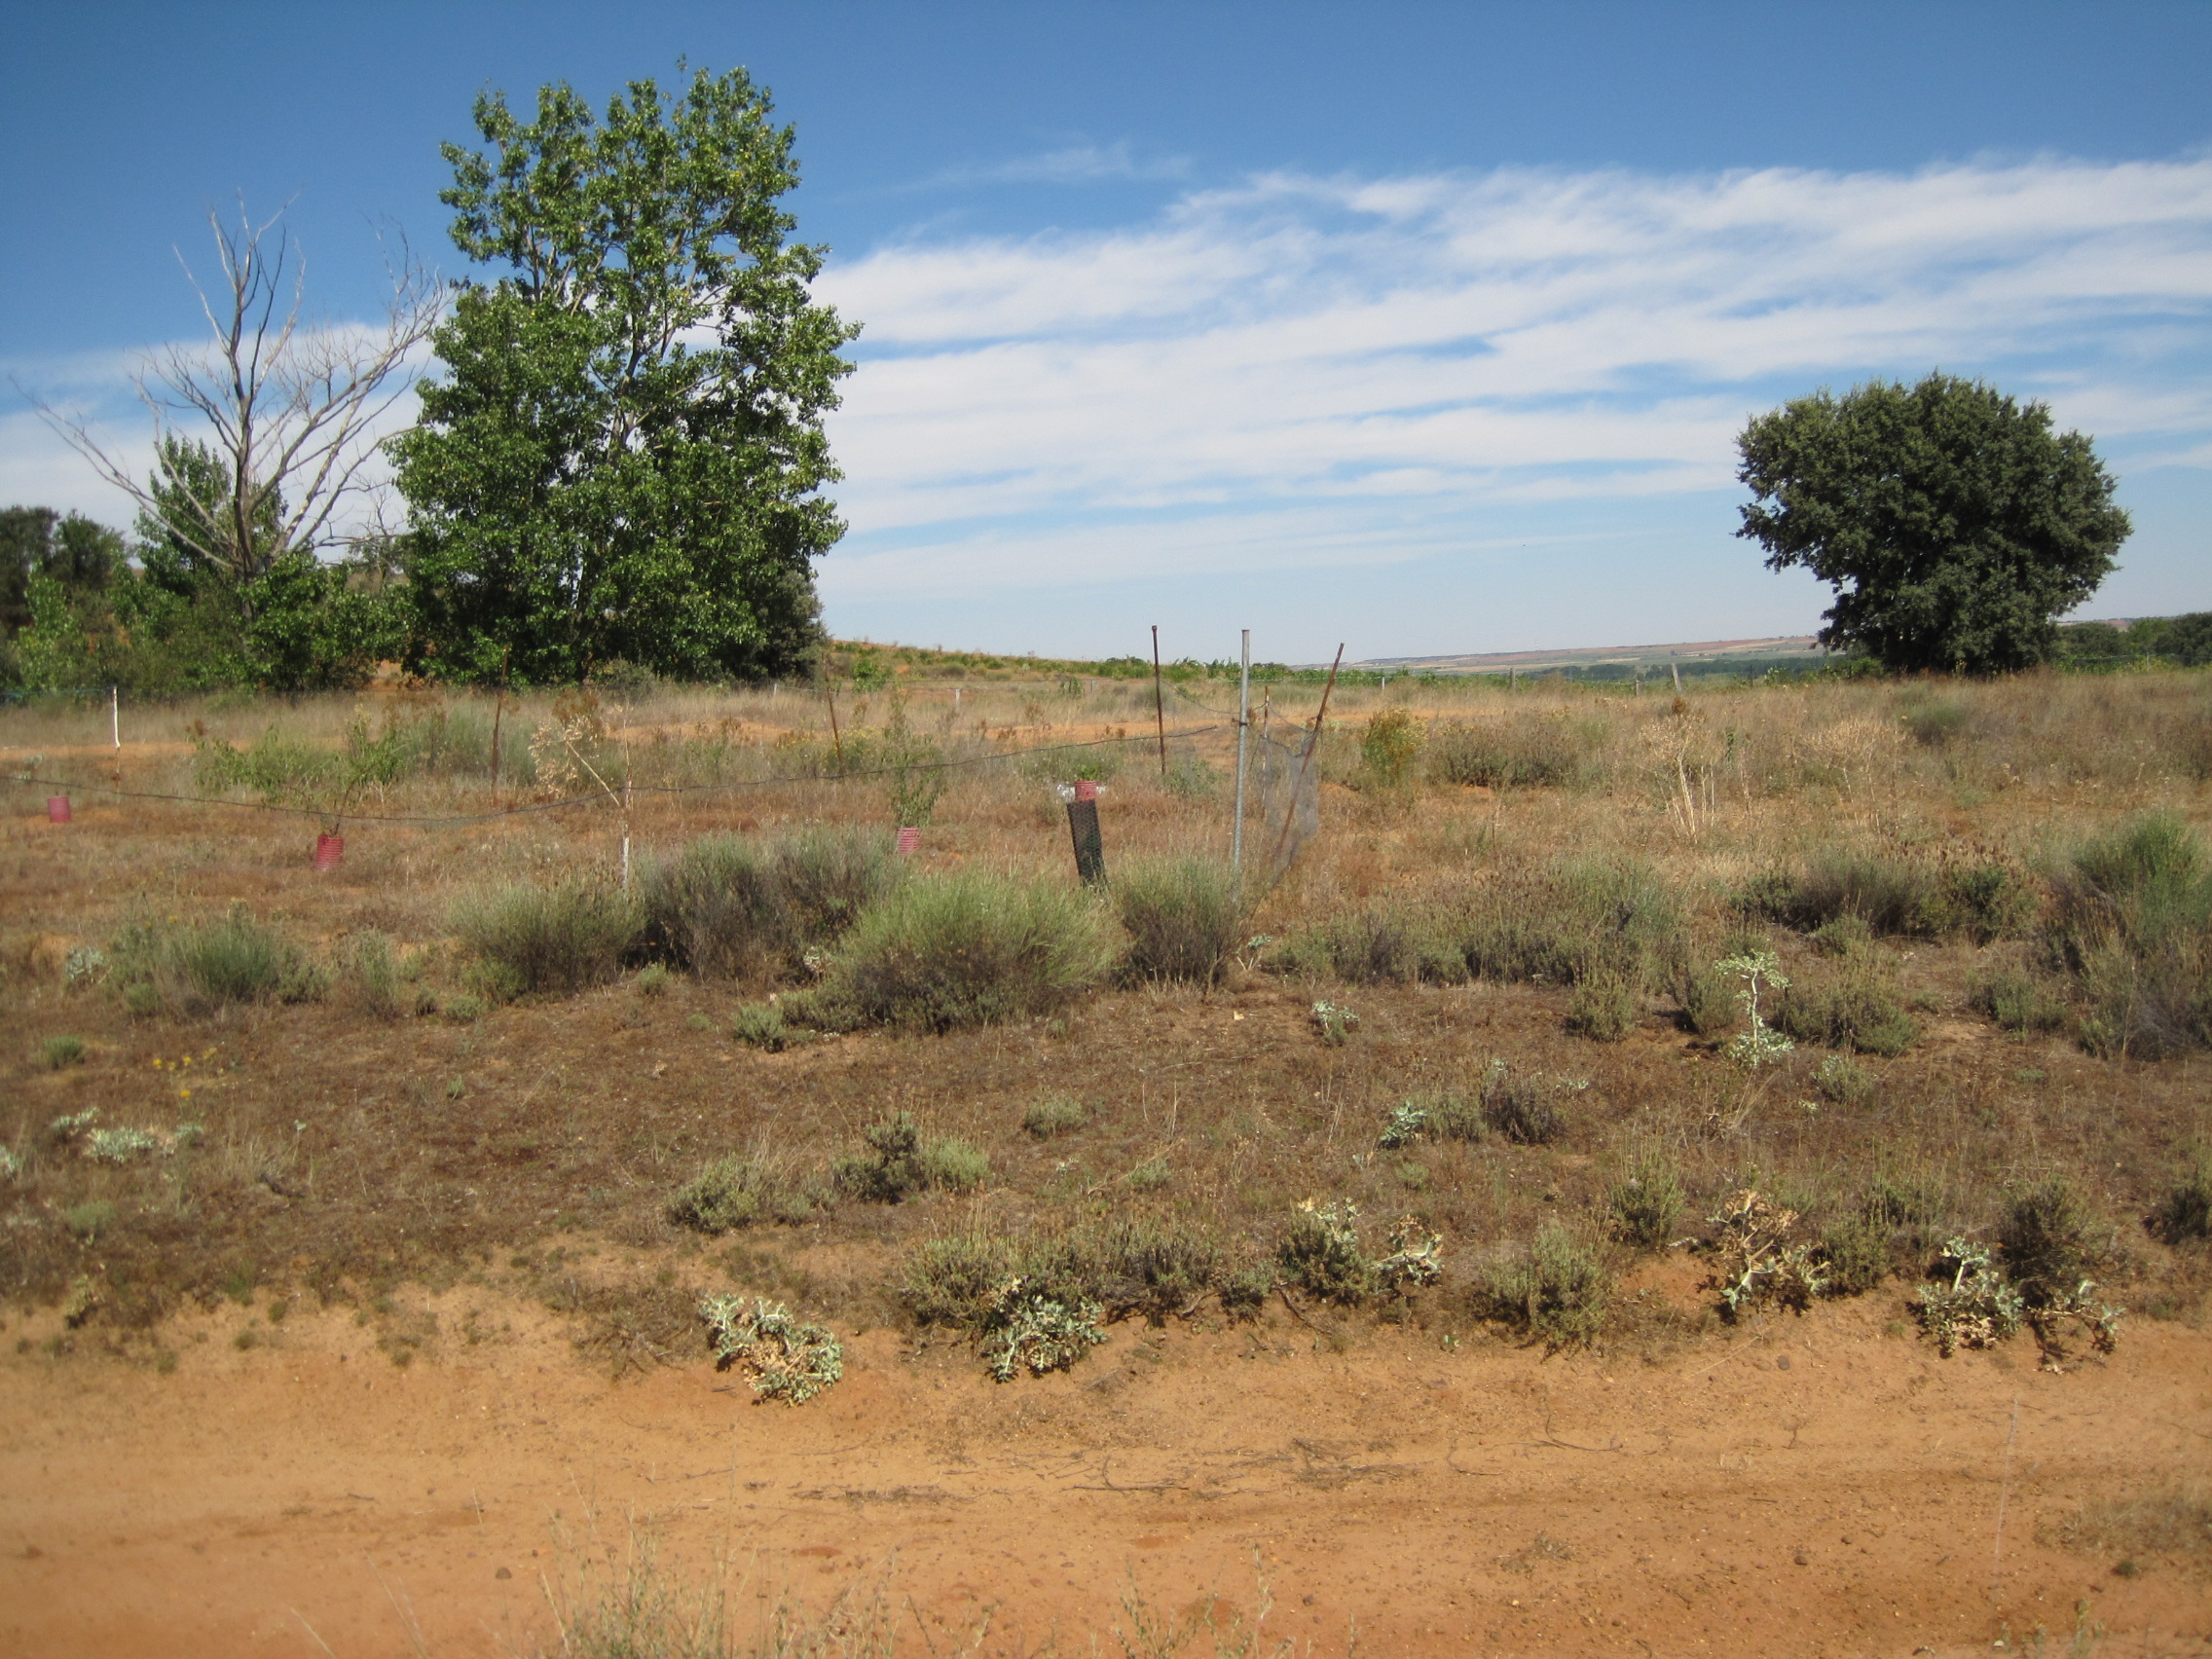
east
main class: Shrubland
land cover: Shrubland with sparse tree cover
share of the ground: 50 - 75 %
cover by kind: shrubs 50 %, herbaceous plants 35 %, unconsolidated bare surface 10 %, broadleaved forest trees 5 %
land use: Semi-natural and natural areas not in use
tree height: < 5 m
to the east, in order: Shrubland with sparse tree cover; Tracks; Spontaneously vegetated surfaces; Fences; Vineyards; Grass margins; Fences; Vineyards; Nuts trees; Fences; Grassland without tree/shrub cover; Vineyards; Grass margins; Other bare soil
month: July
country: ES
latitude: 42.1498
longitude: -5.6183
